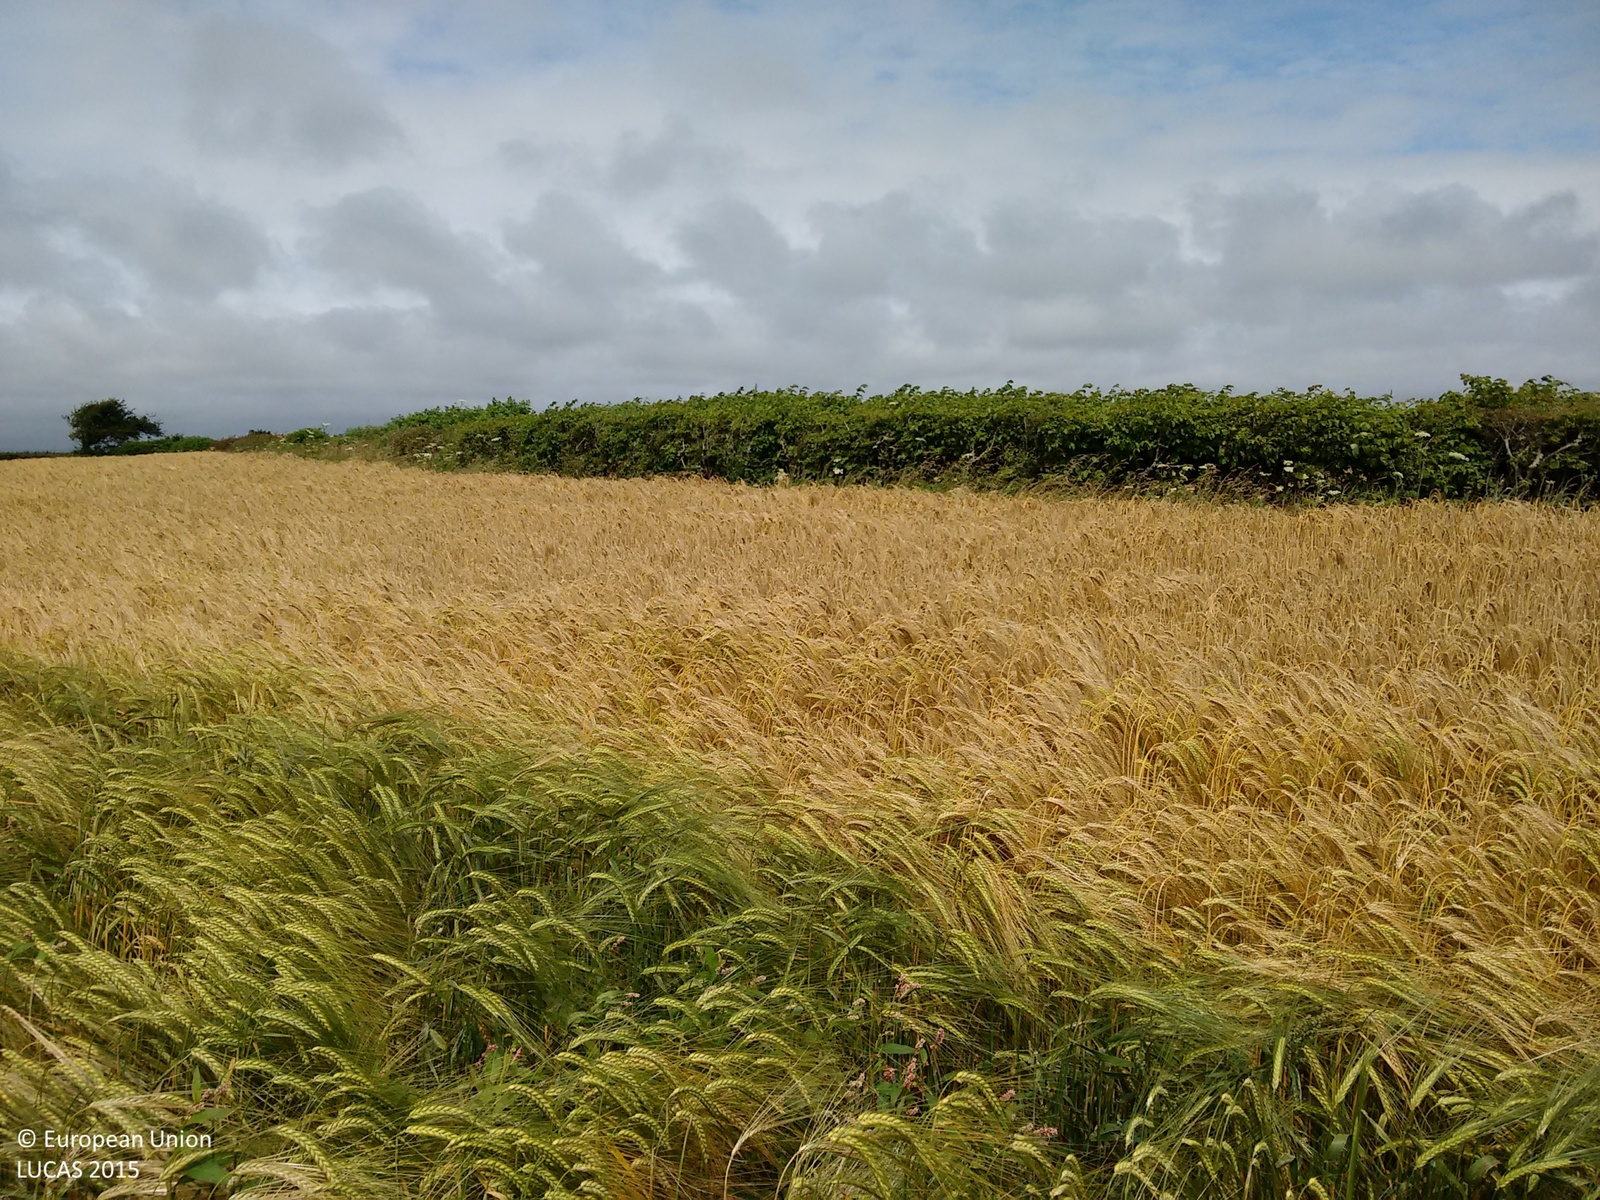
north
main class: Cropland
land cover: Barley
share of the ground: > 75 %
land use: Agriculture (excluding fallow land and kitchen gardens)
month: July
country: GB
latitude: 51.4334
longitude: -3.5346
